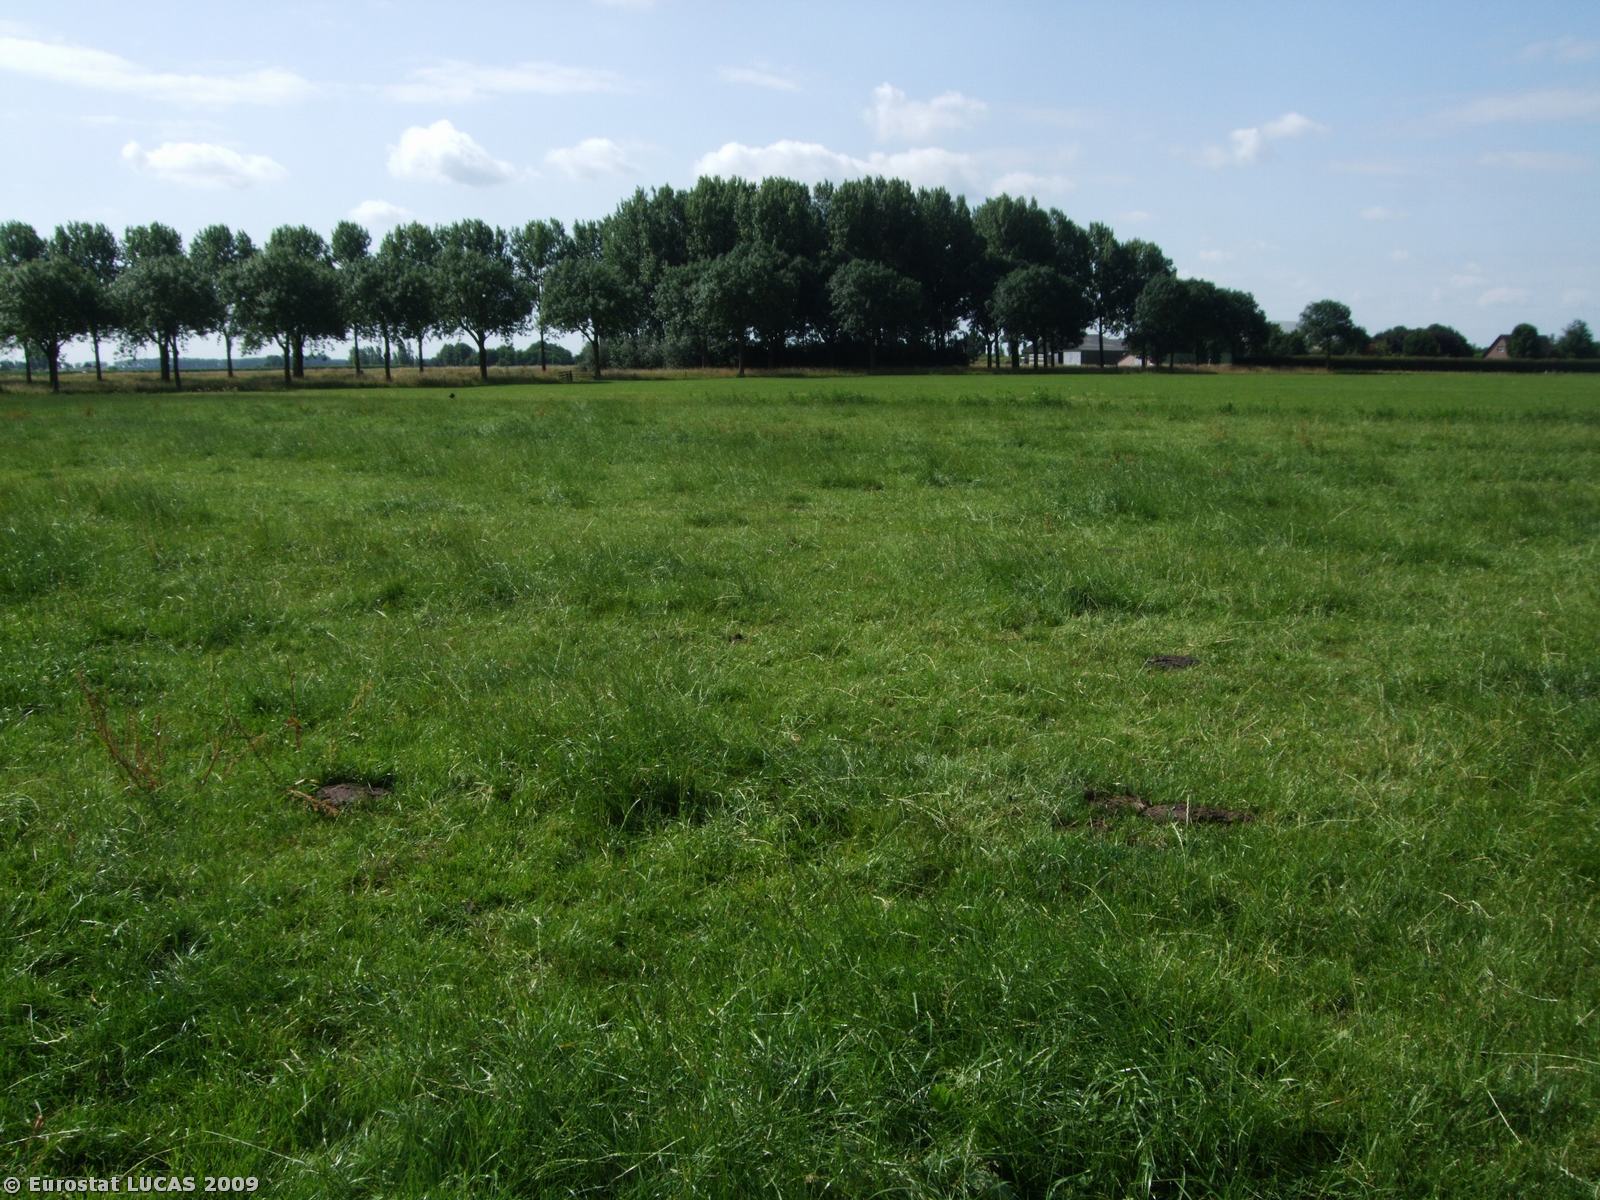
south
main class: Grassland
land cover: Grassland without tree/shrub cover
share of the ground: > 75 %
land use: Agriculture (excluding fallow land and kitchen gardens)
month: July
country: NL
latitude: 51.9435
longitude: 5.3282
